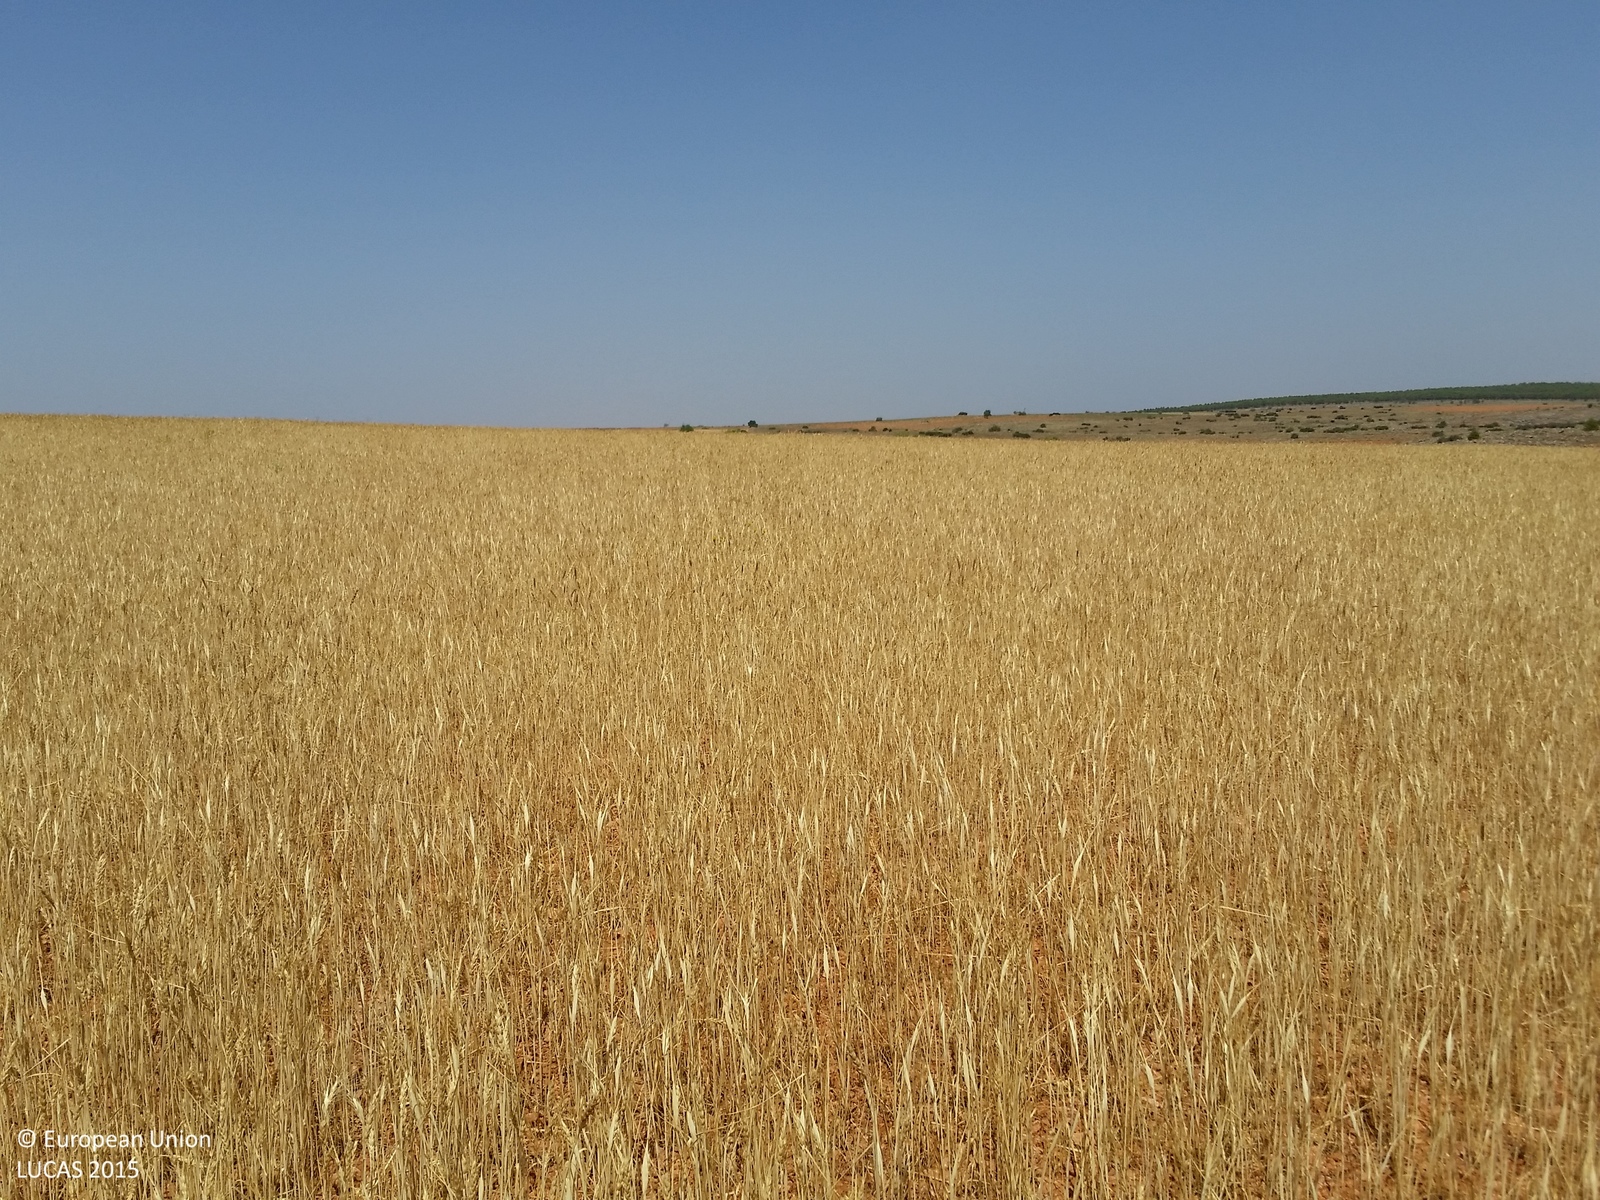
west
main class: Cropland
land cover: Common wheat
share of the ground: > 75 %
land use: Agriculture (excluding fallow land and kitchen gardens)
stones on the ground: 10 - 25 %
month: July
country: ES
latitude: 38.9045
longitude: -2.5857
